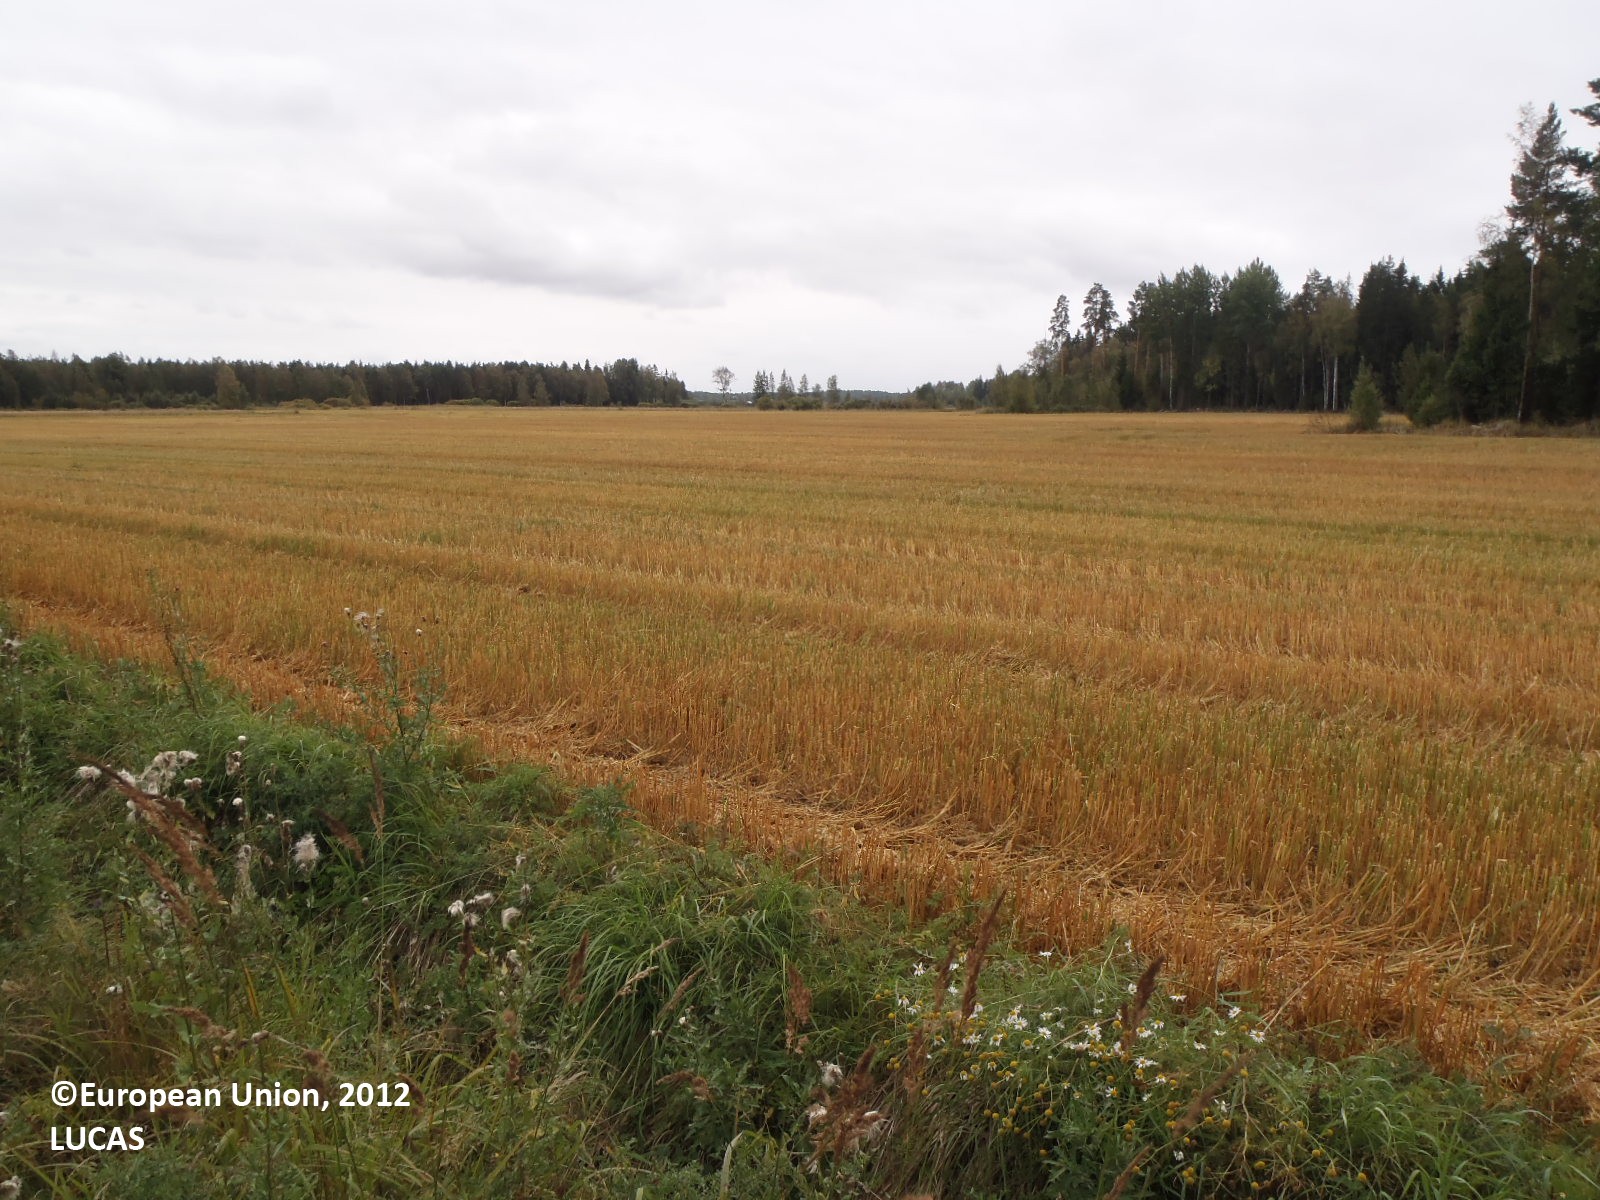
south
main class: Cropland
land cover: Common wheat
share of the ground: > 75 %
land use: Agriculture (excluding fallow land and kitchen gardens)
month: September
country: FI
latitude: 60.9447
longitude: 22.8273
